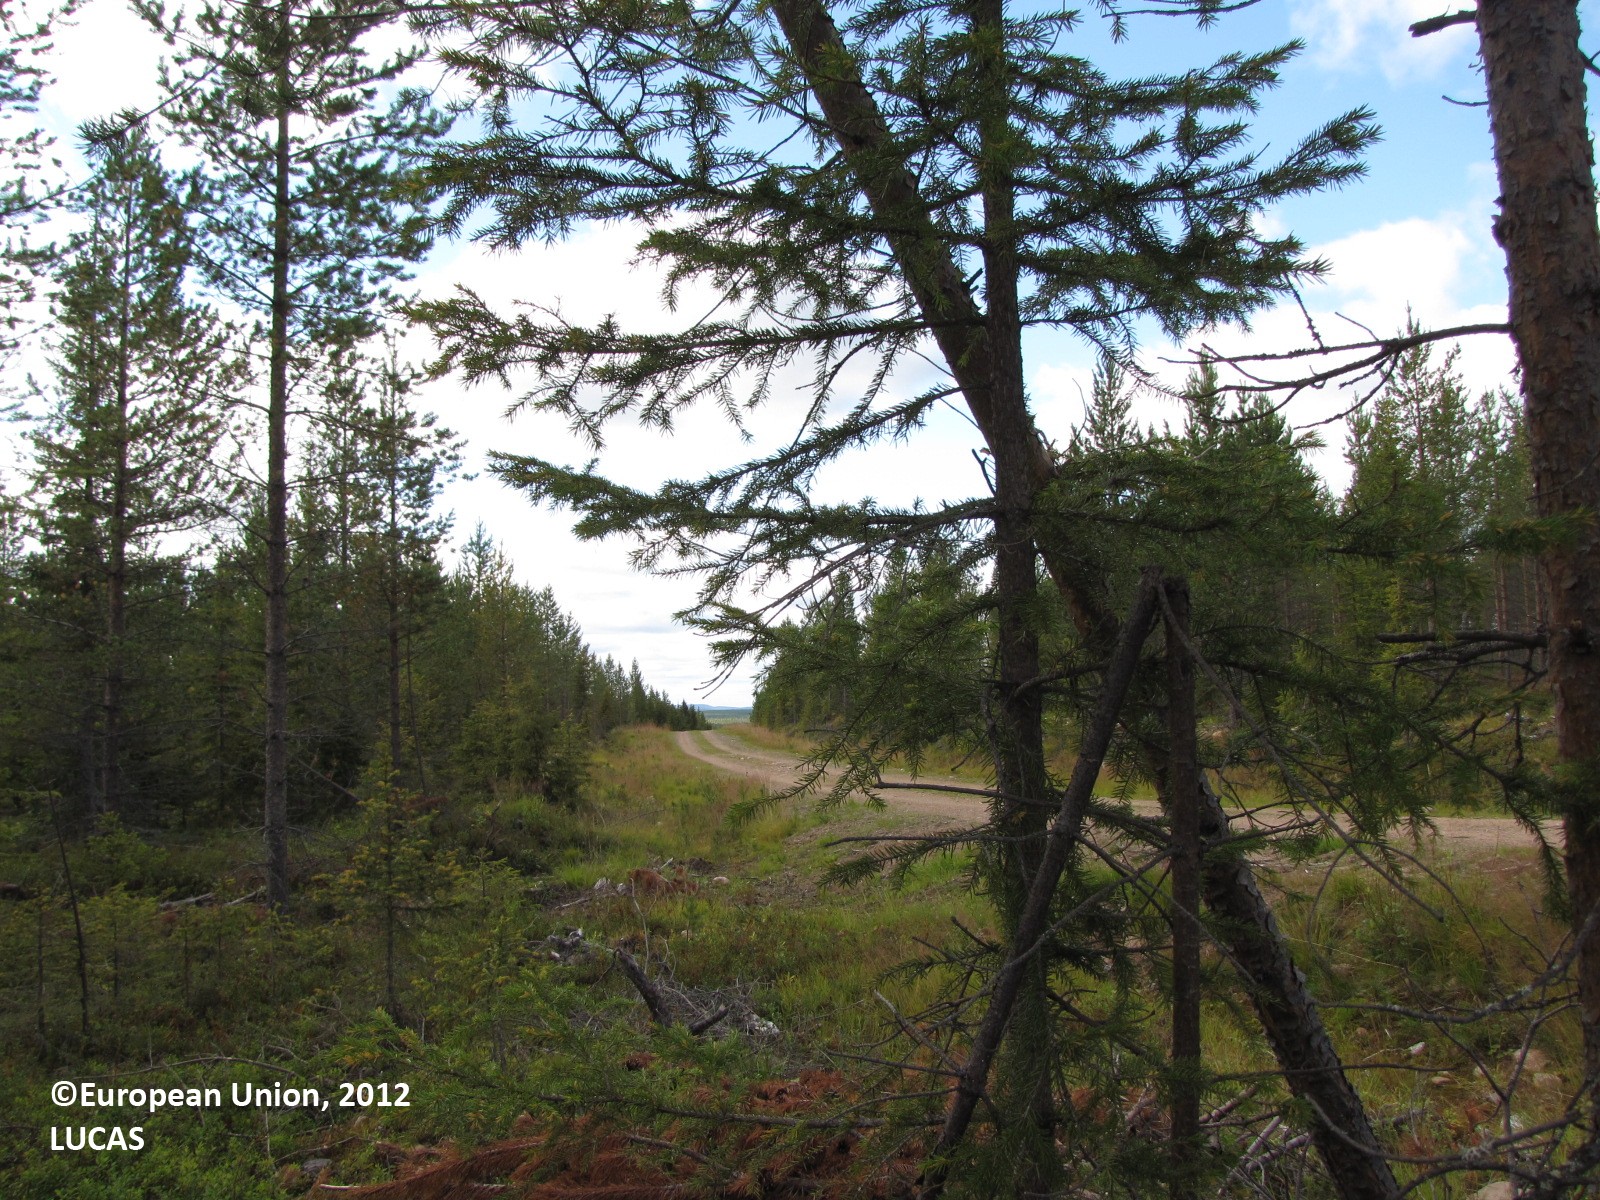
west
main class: Woodland
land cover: Pine dominated coniferous woodland
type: boreal forest
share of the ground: 25 - 50 %
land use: Forestry
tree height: > 5 m
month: August
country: FI
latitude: 66.9623
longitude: 25.0938
